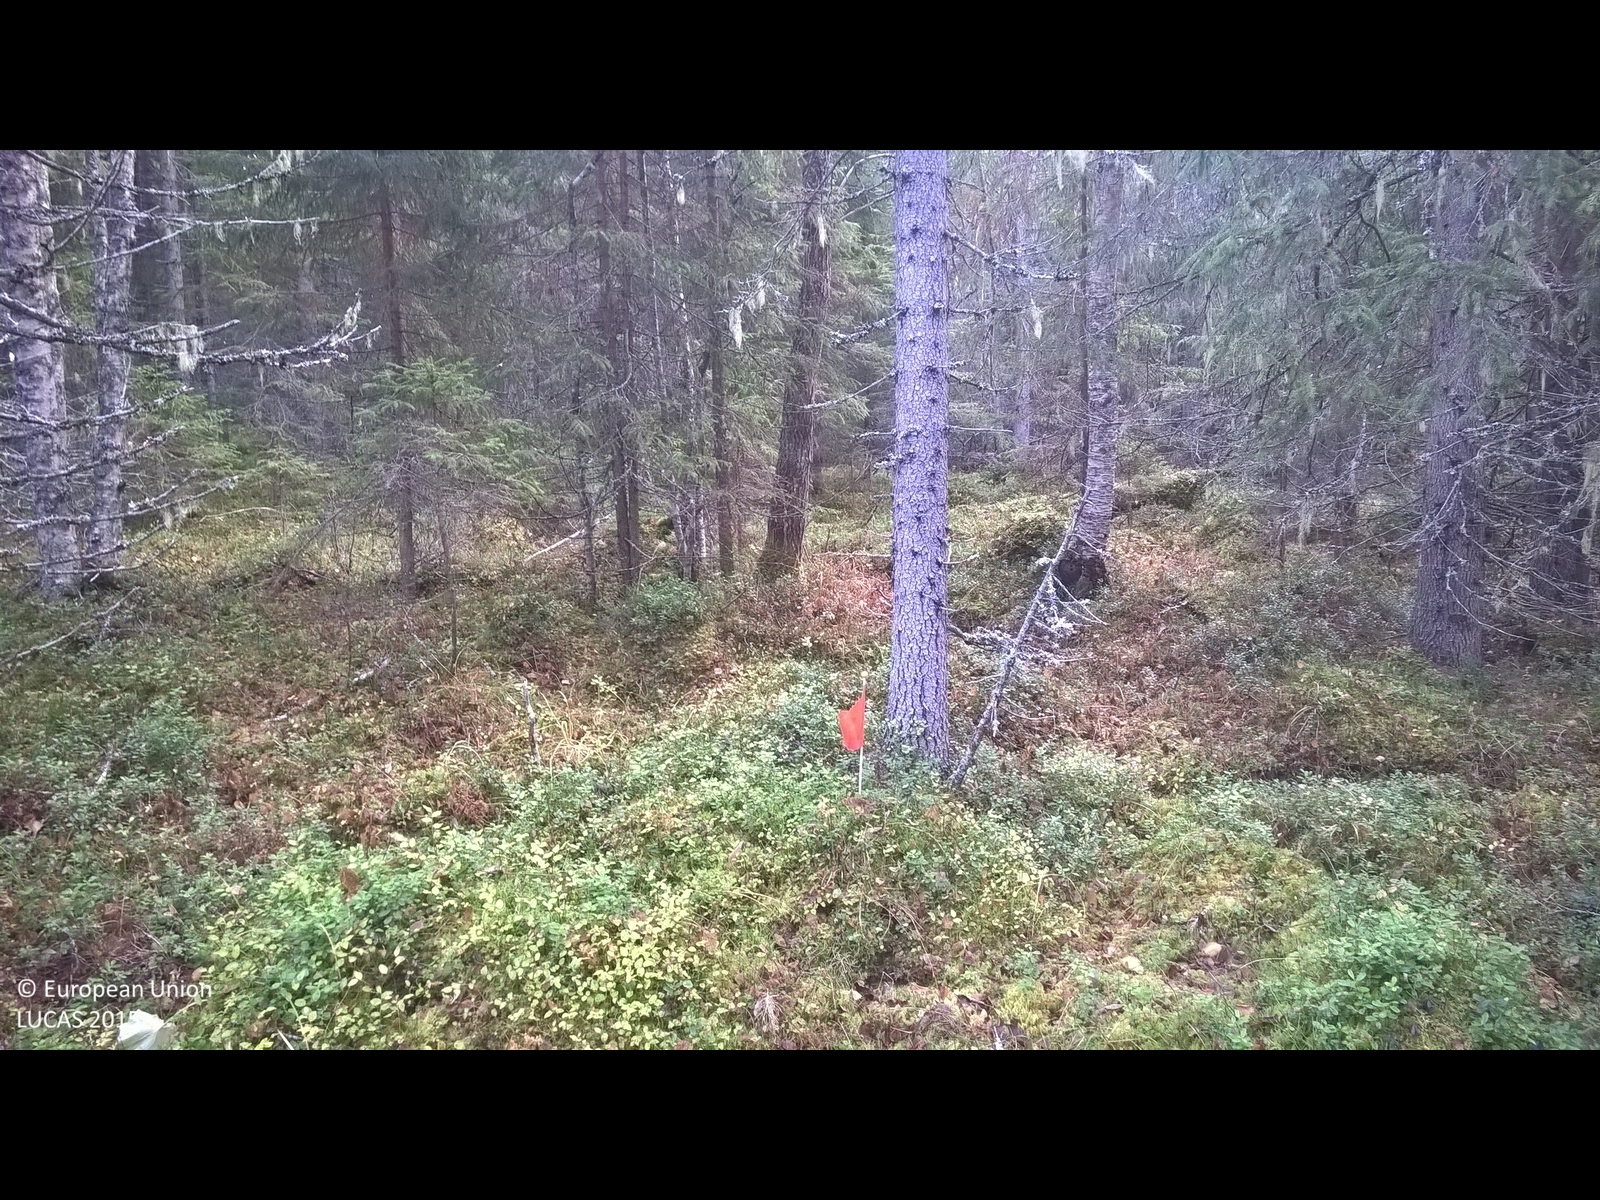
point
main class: Woodland
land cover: Spruce dominated coniferous woodland
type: boreal forest
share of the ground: 50 - 75 %
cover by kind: coniferous forest trees 60 %, lichens and mosses 30 %, broadleaved forest trees 10 %
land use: Forestry
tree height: > 5 m
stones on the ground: < 10 %
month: October
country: SE
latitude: 63.3388
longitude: 13.8759
